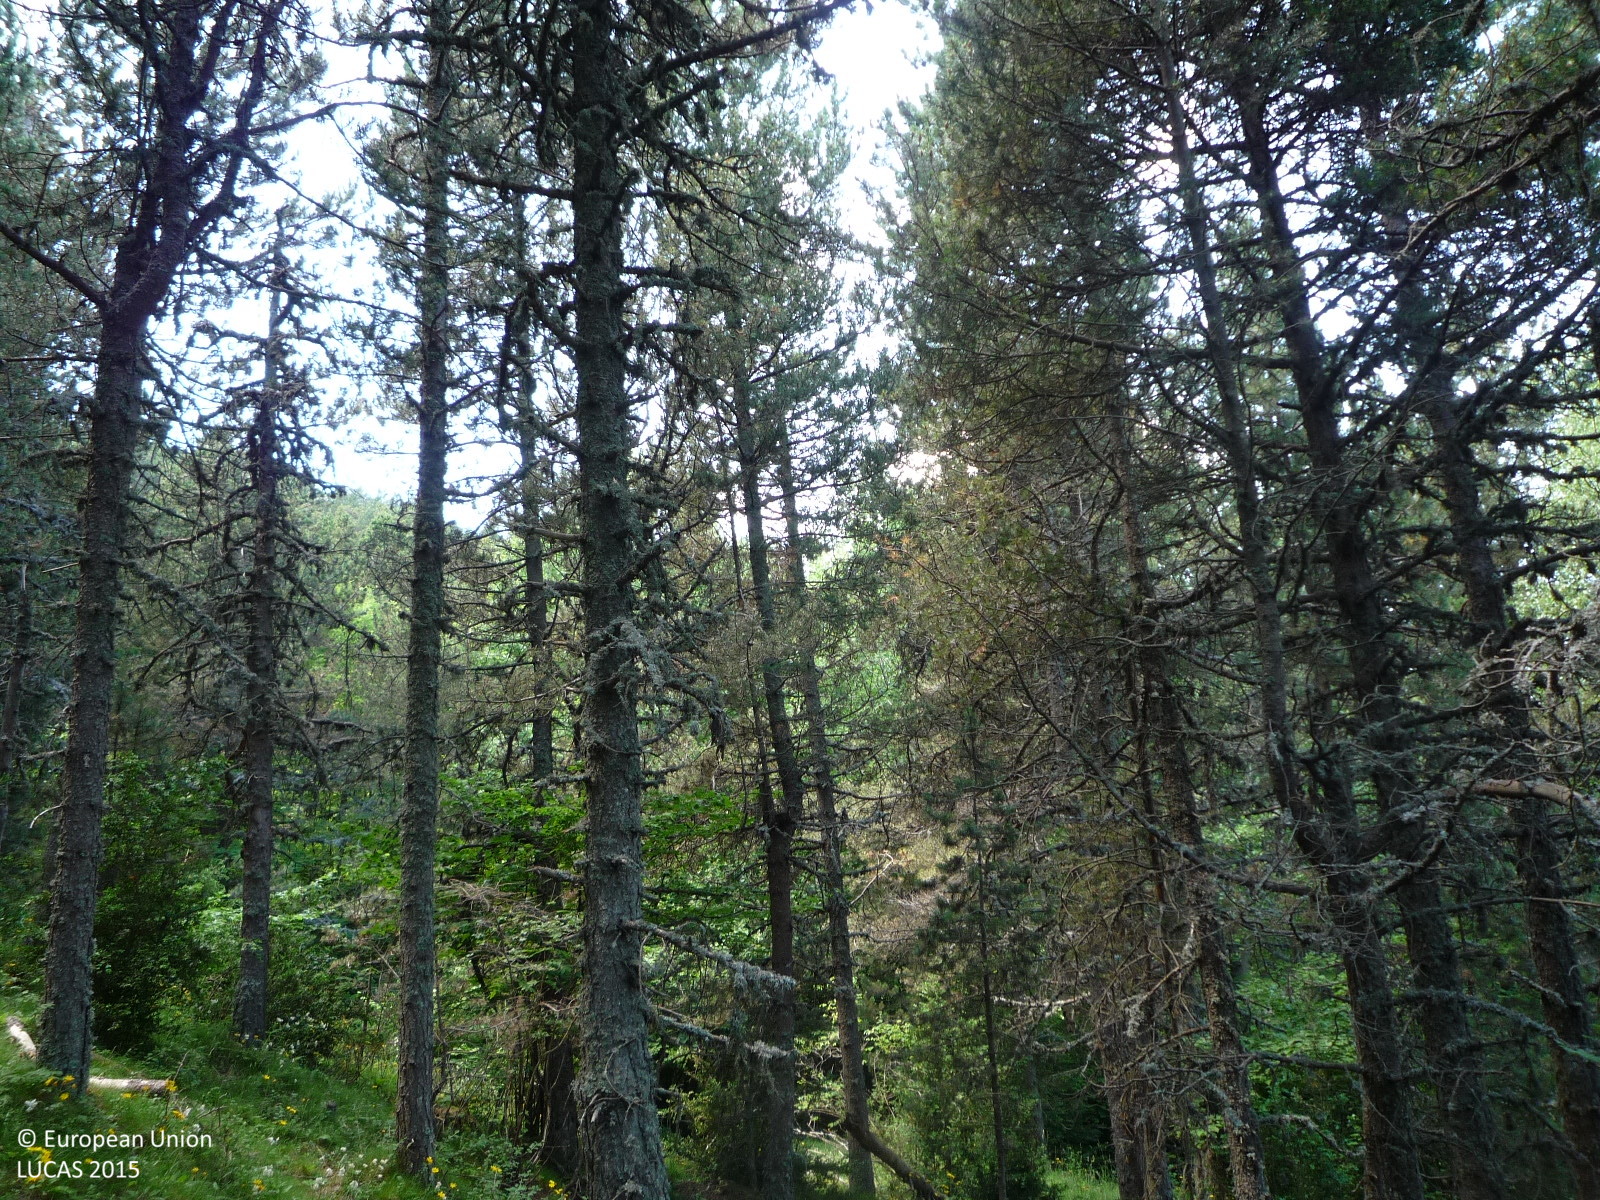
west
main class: Woodland
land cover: Pine dominated coniferous woodland
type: alpine coniferous forest
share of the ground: > 75 %
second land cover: Grassland without tree/shrub cover
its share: 10 - 25 %
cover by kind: coniferous forest trees 90 %, herbaceous plants 10 %
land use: Forestry
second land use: Agriculture (excluding fallow land and kitchen gardens)
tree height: > 5 m
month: June
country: ES
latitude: 42.3485
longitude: 1.9147
